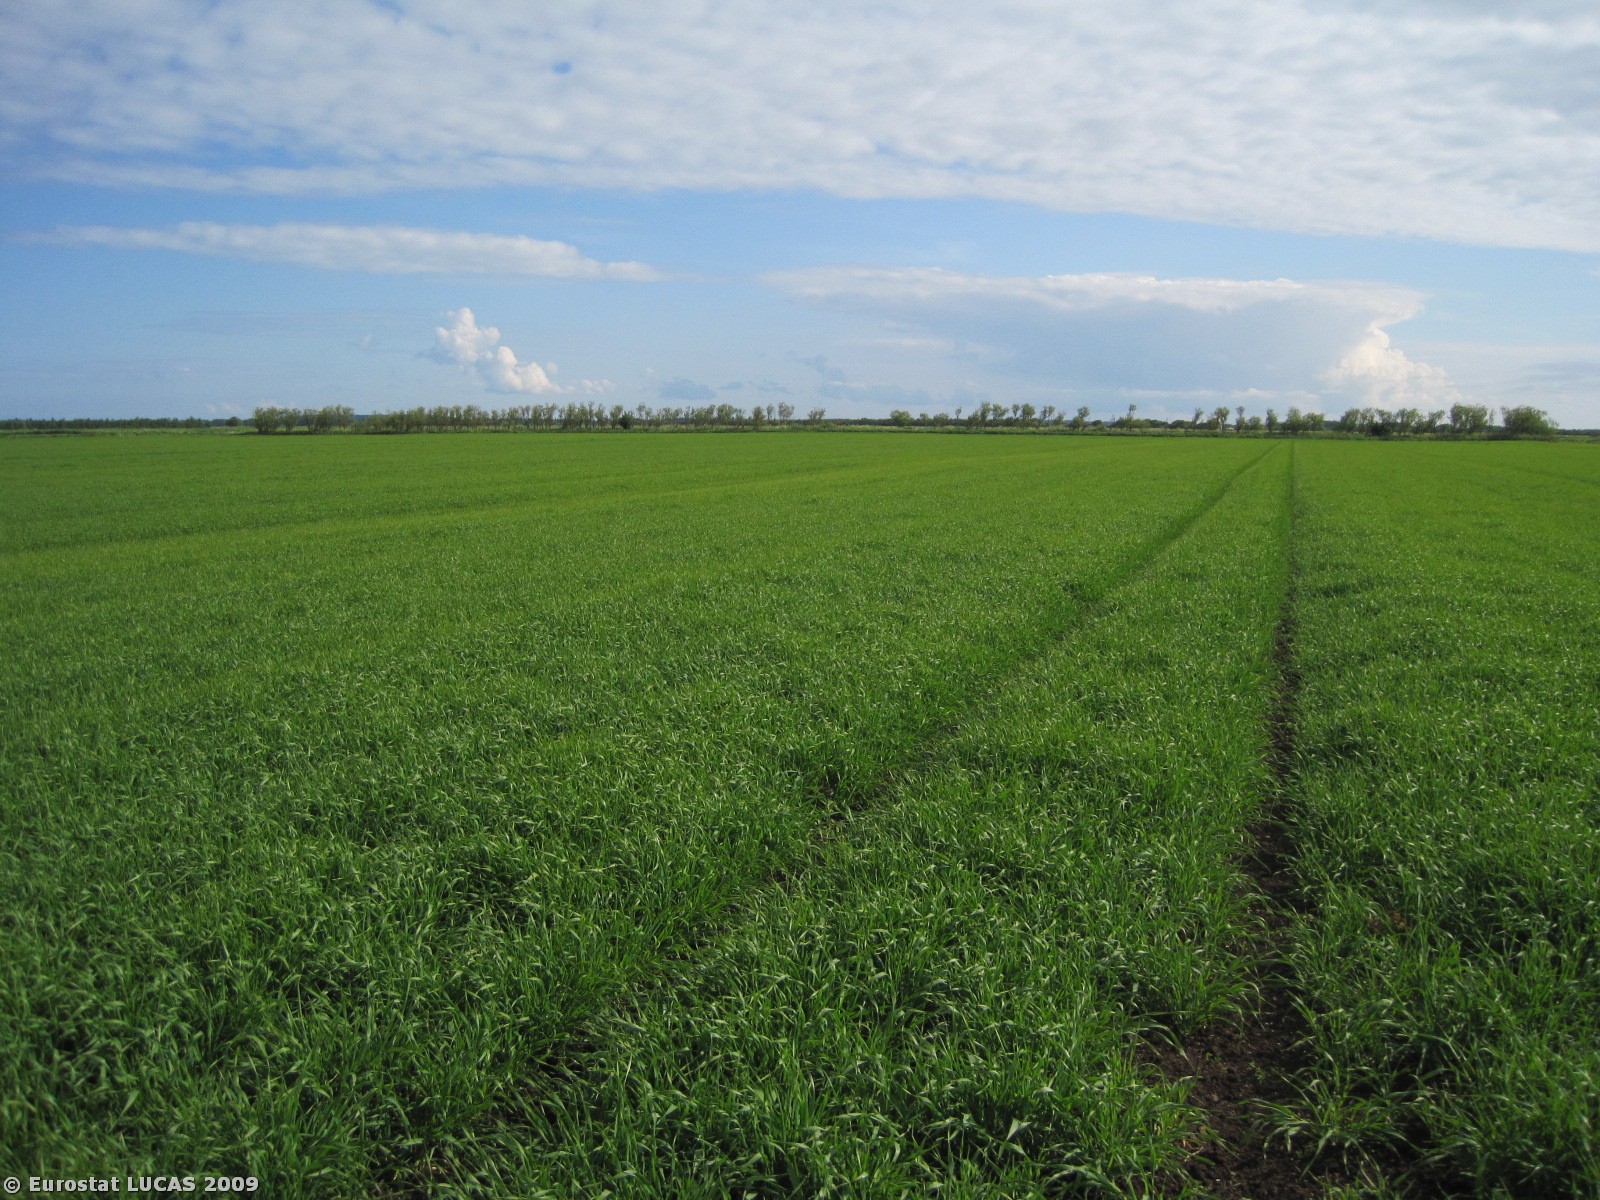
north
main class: Cropland
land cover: Barley
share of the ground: > 75 %
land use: Agriculture (excluding fallow land and kitchen gardens)
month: June
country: DK
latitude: 57.2123
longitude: 9.8182
